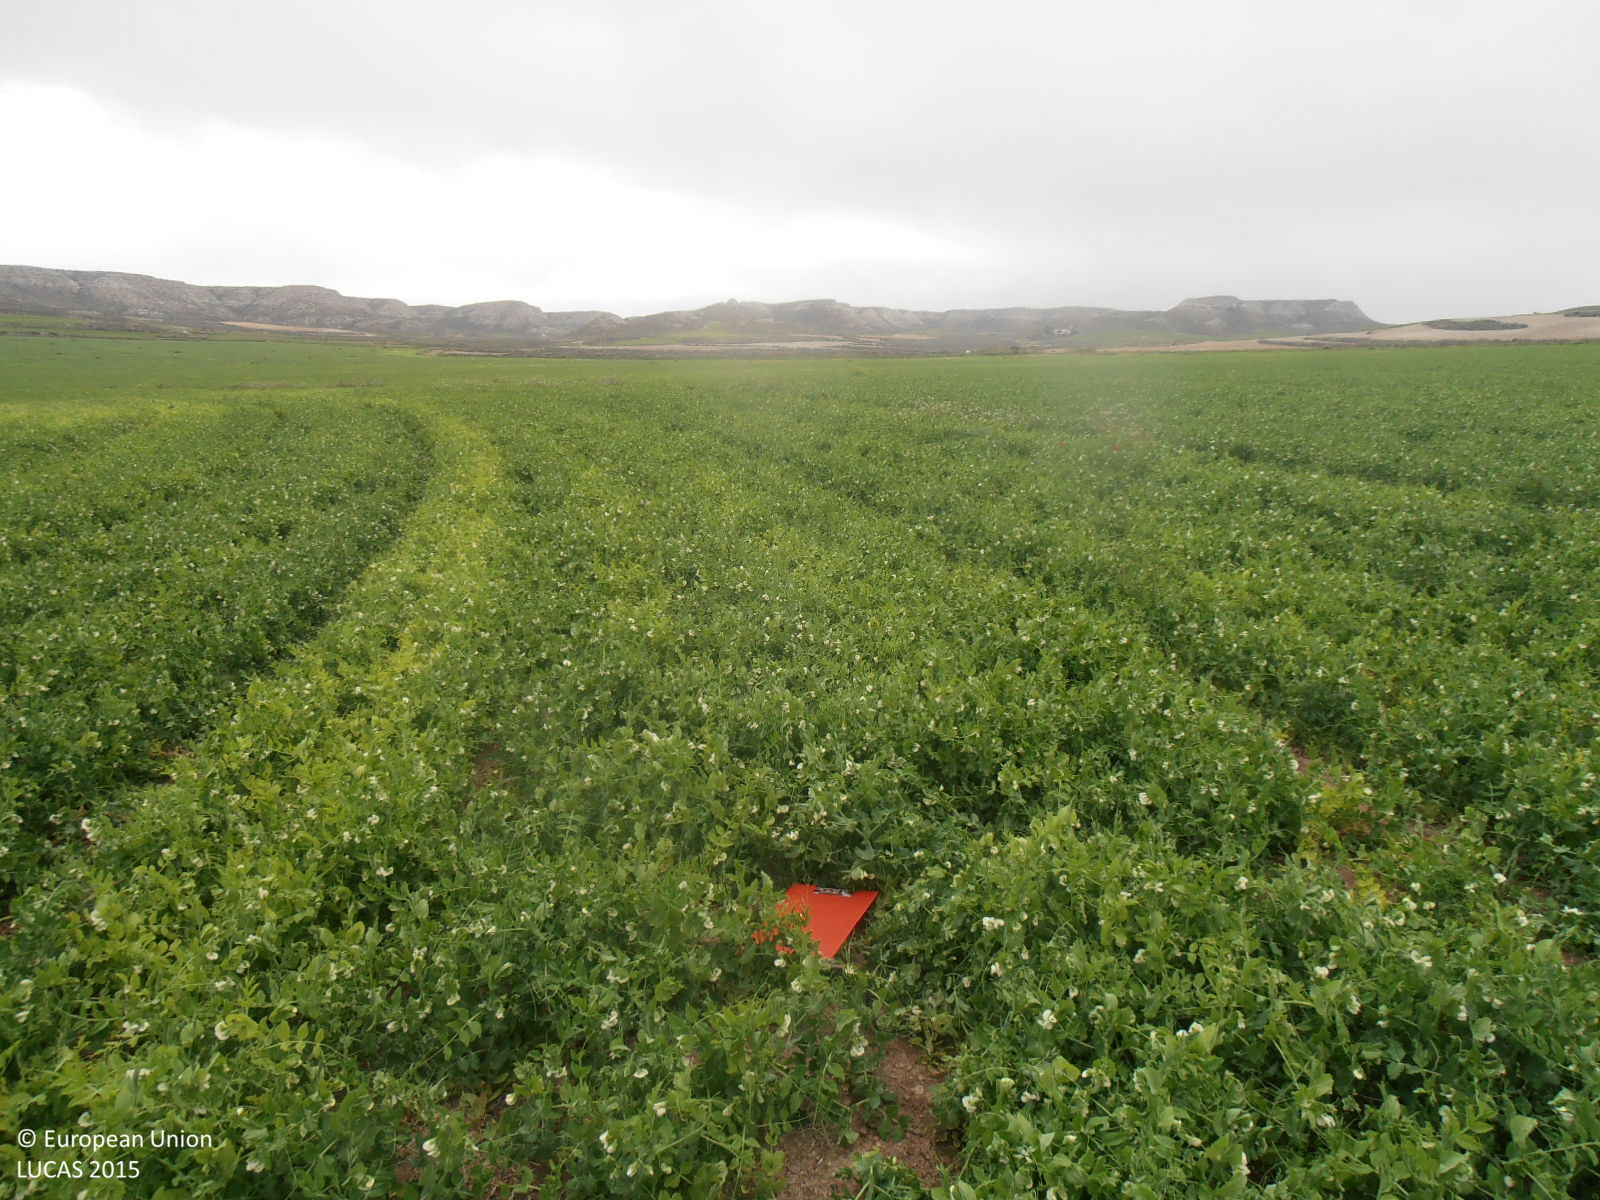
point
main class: Cropland
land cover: Dry pulses
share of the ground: > 75 %
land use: Agriculture (excluding fallow land and kitchen gardens)
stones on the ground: < 10 %
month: April
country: ES
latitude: 41.4445
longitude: -0.3938
